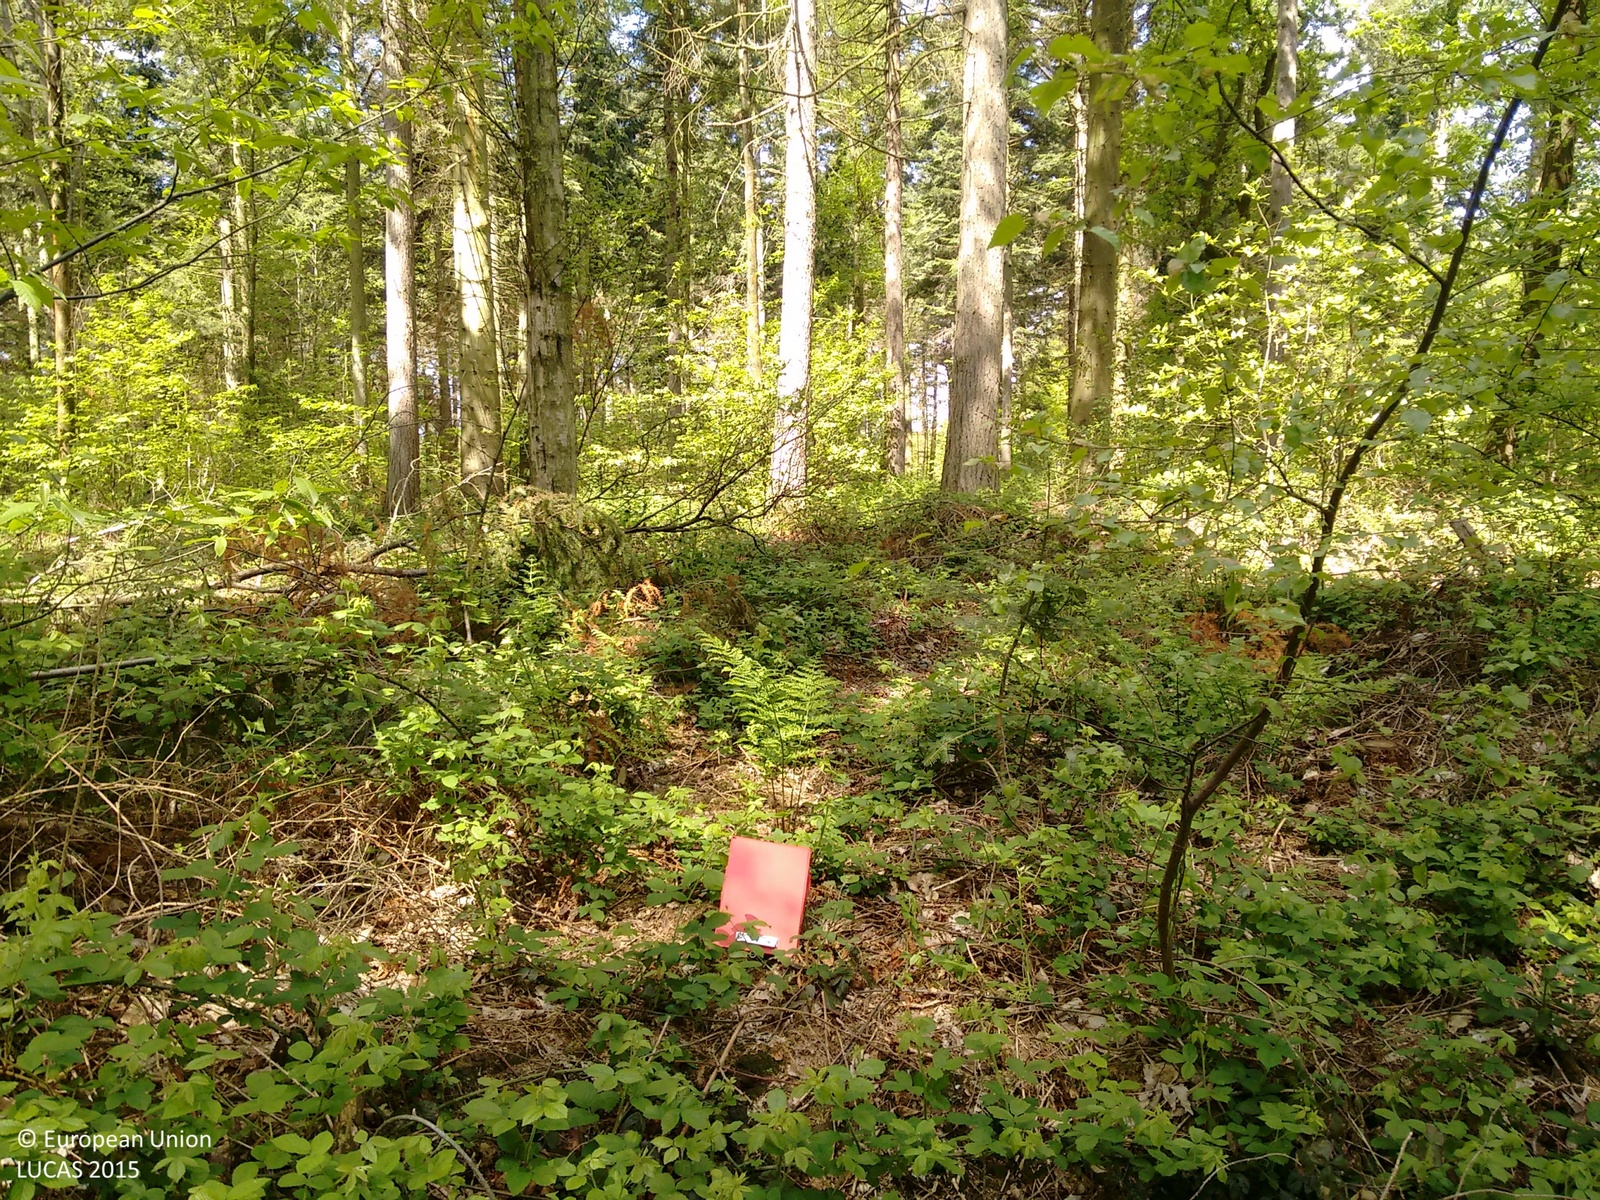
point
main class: Woodland
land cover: Spruce dominated mixed woodland
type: exotic forest
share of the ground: > 75 %
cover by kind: coniferous forest trees 75 %, broadleaved forest trees 25 %
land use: Forestry
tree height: > 5 m
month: May
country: GB
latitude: 51.1740
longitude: 1.0950
